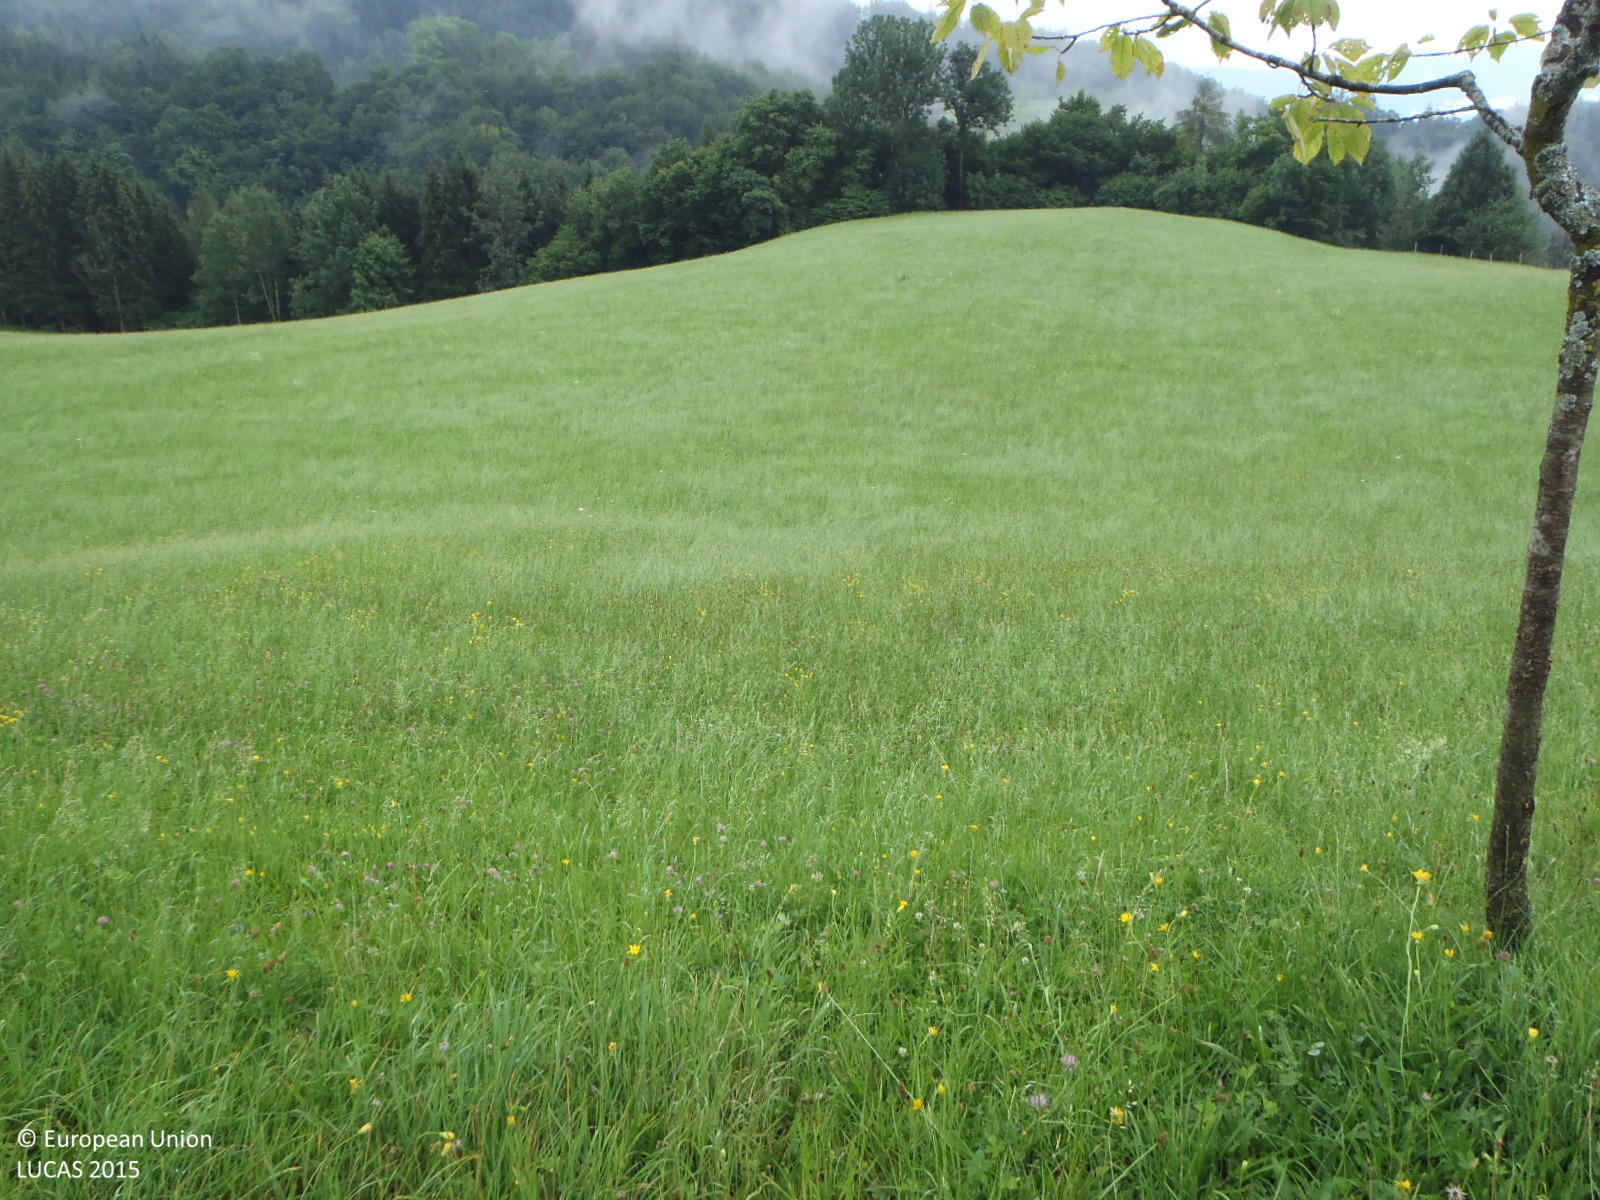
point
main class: Grassland
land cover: Grassland without tree/shrub cover
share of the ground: > 75 %
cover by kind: herbaceous plants 100 %
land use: Agriculture (excluding fallow land and kitchen gardens)
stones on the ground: < 10 %
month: July
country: AT
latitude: 47.6796
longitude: 12.1965
